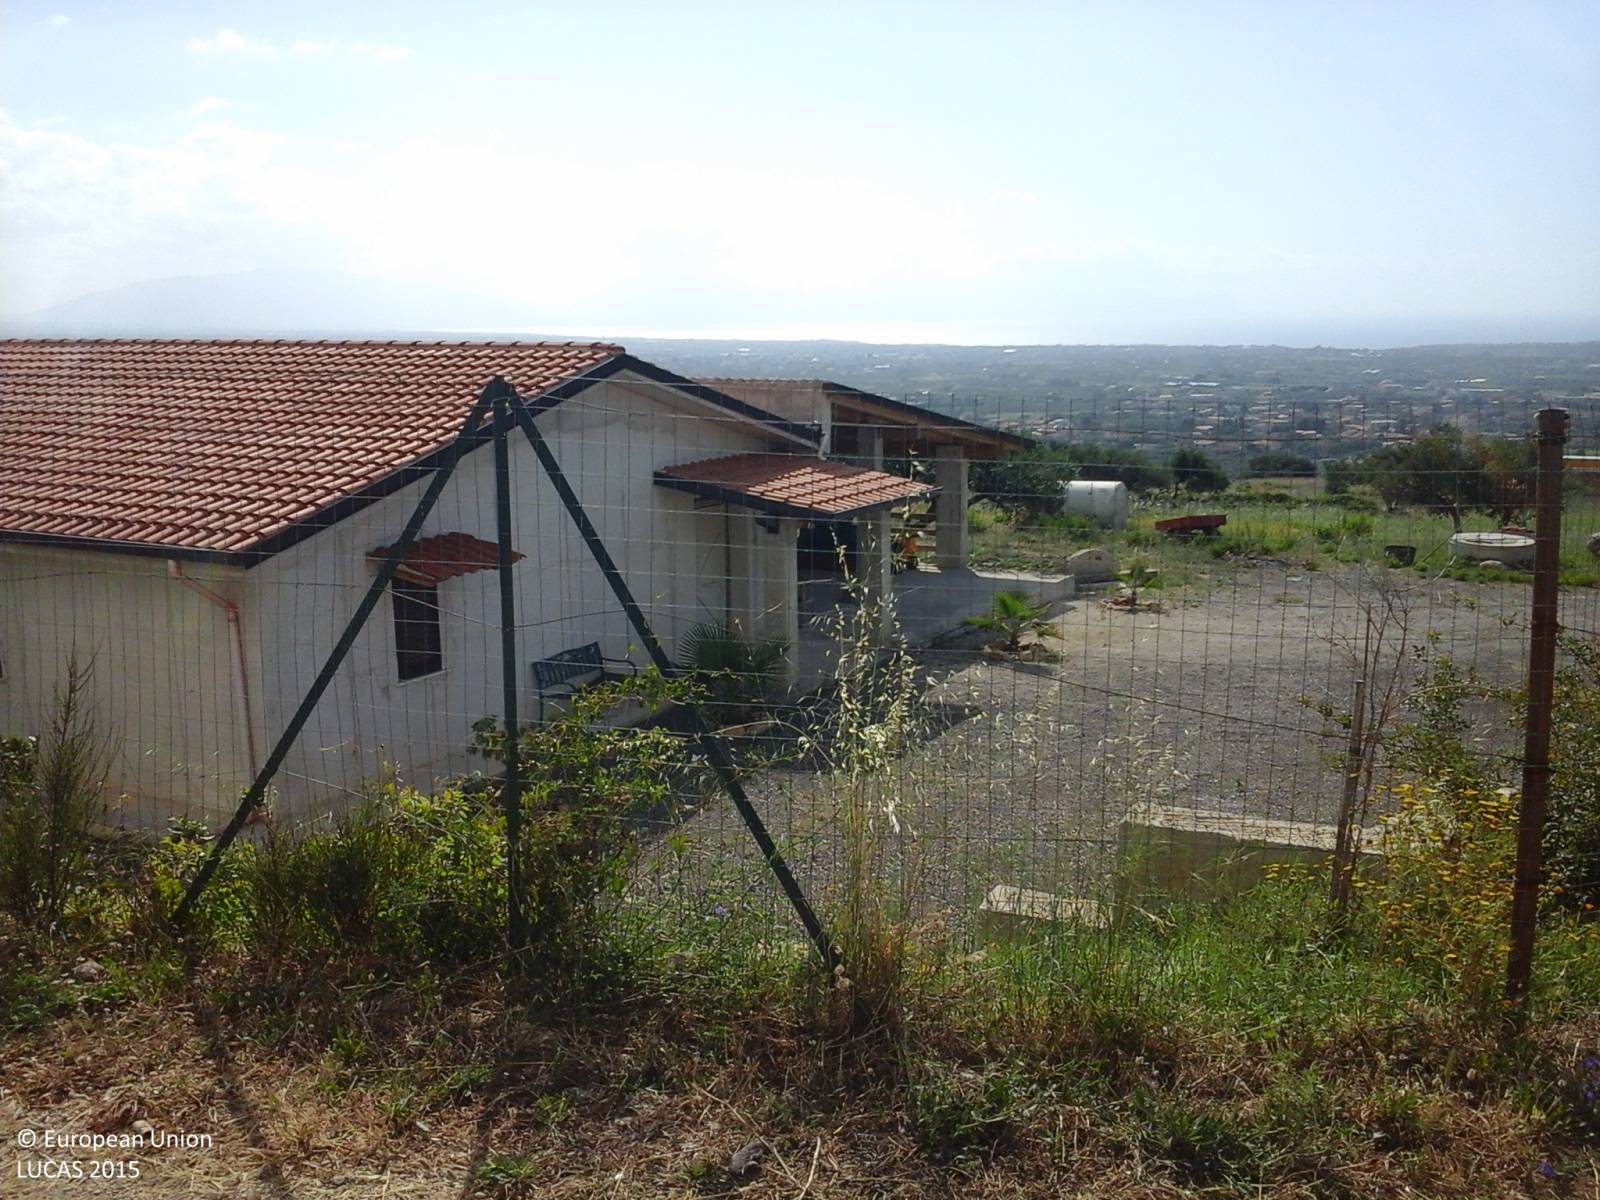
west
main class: Cropland
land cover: Vineyards
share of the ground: 25 - 50 %
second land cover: Olive groves
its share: 25 - 50 %
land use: Agriculture (excluding fallow land and kitchen gardens)
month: June
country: IT
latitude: 38.0584
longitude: 13.1574
